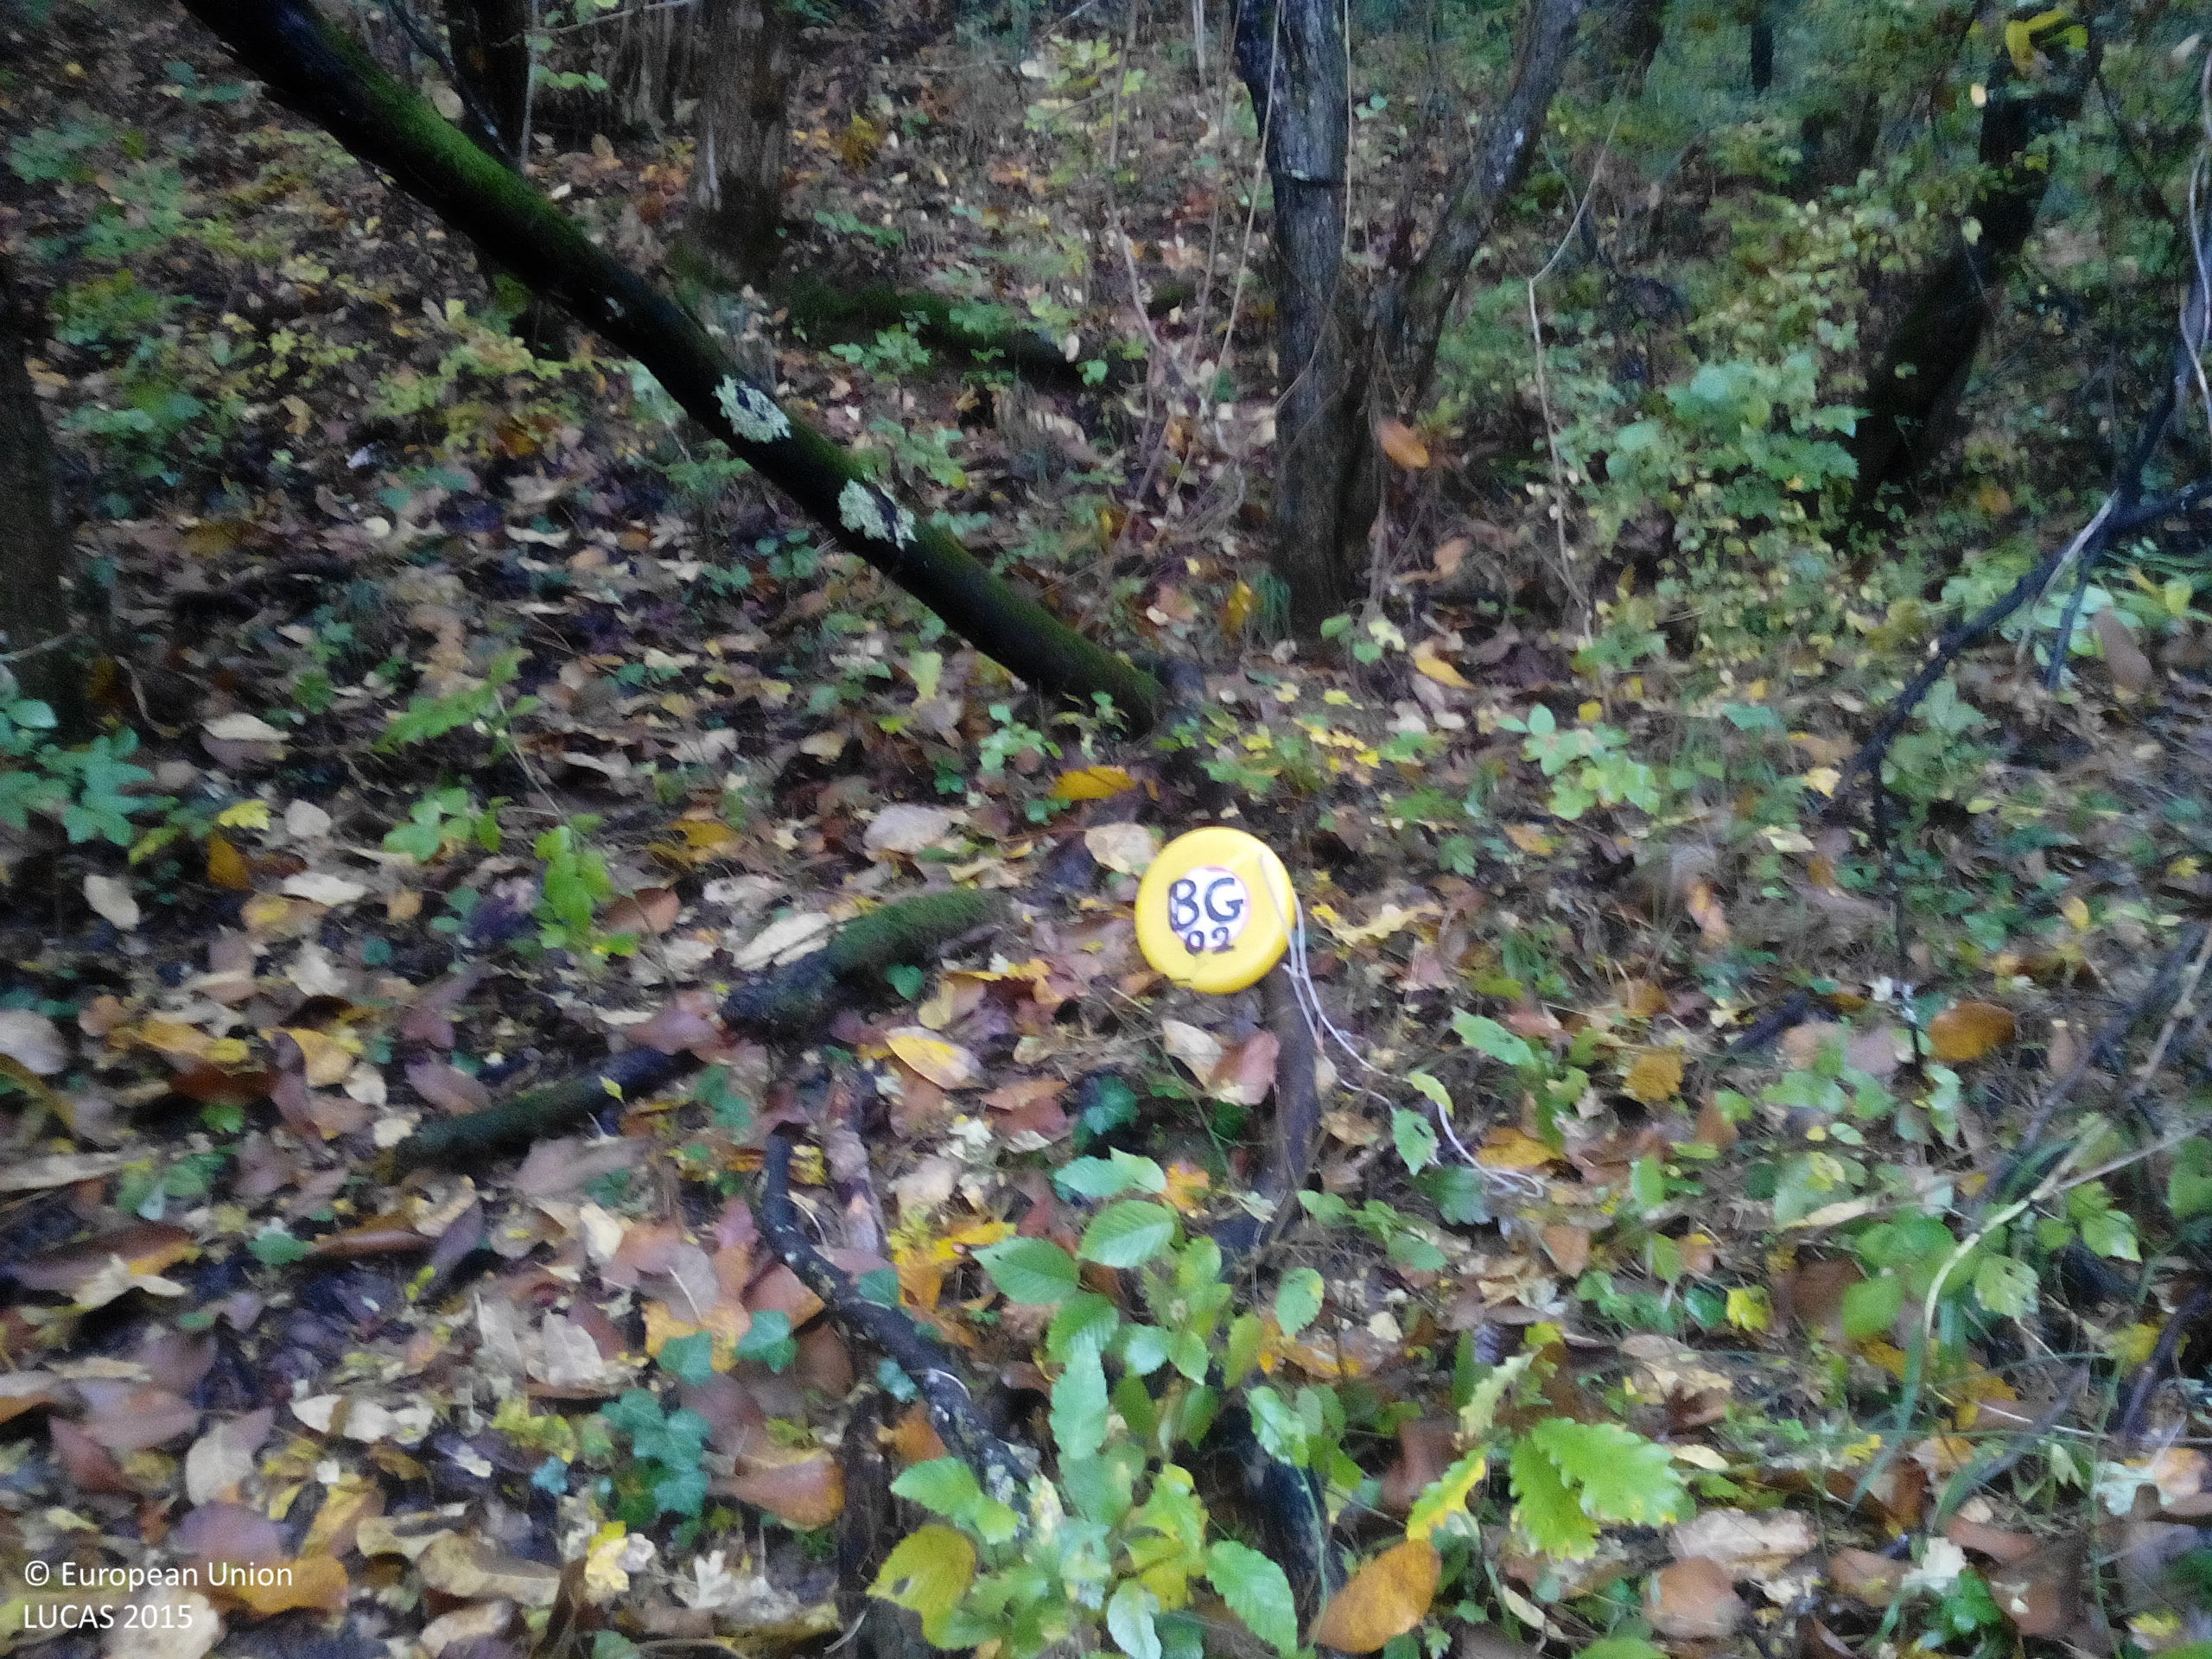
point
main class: Woodland
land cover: Broadleaved woodland
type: beech forest
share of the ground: > 75 %
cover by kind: broadleaved forest trees 95 %, shrubs 5 %
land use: Forestry
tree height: > 5 m
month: October
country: BG
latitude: 43.0218
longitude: 24.4498
